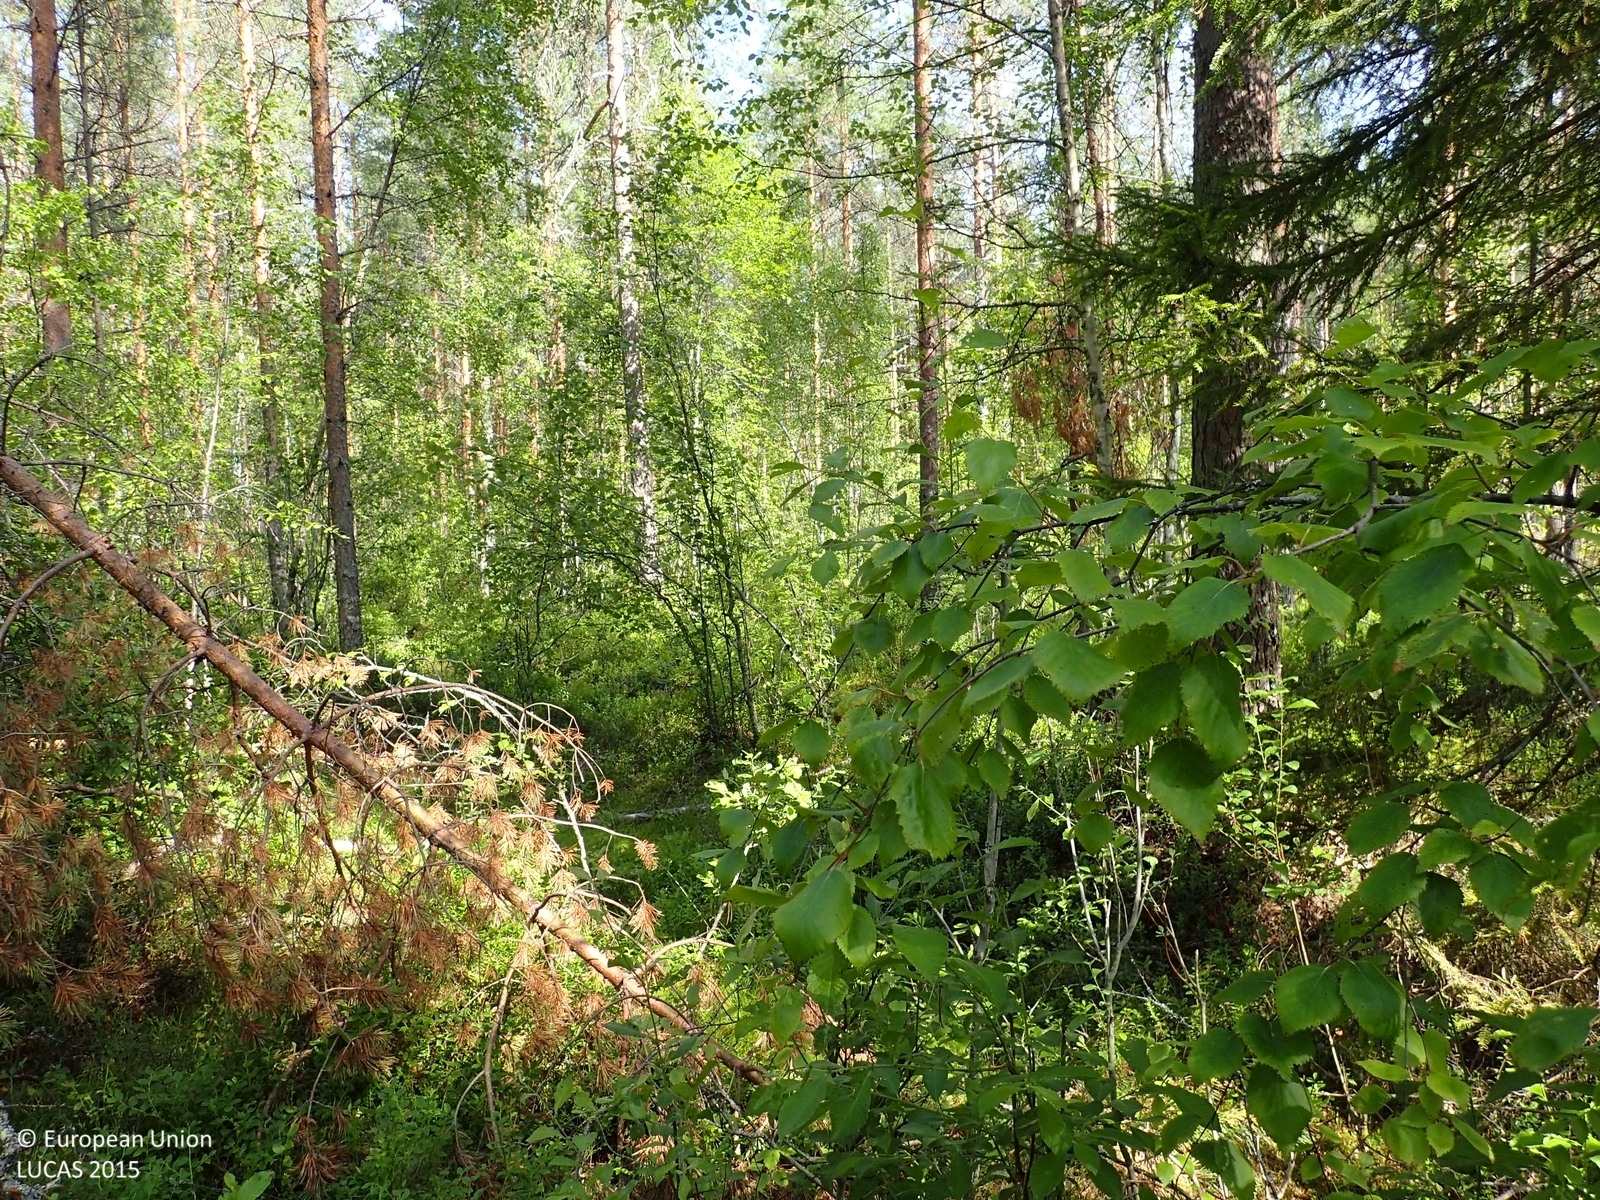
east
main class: Woodland
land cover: Pine dominated coniferous woodland
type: boreal forest
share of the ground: 50 - 75 %
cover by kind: coniferous forest trees 55 %, shrubs 30 %, broadleaved forest trees 10 %, herbaceous plants 5 %
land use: Forestry
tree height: > 5 m
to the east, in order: Pine dominated coniferous woodland; Ditches and canals; Pine dominated coniferous woodland; Ditches and canals; Pine dominated coniferous woodland; Ditches and canals; Pine dominated coniferous woodland; Ditches and canals; Pine dominated coniferous woodland
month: July
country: FI
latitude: 62.9241
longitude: 23.6378
